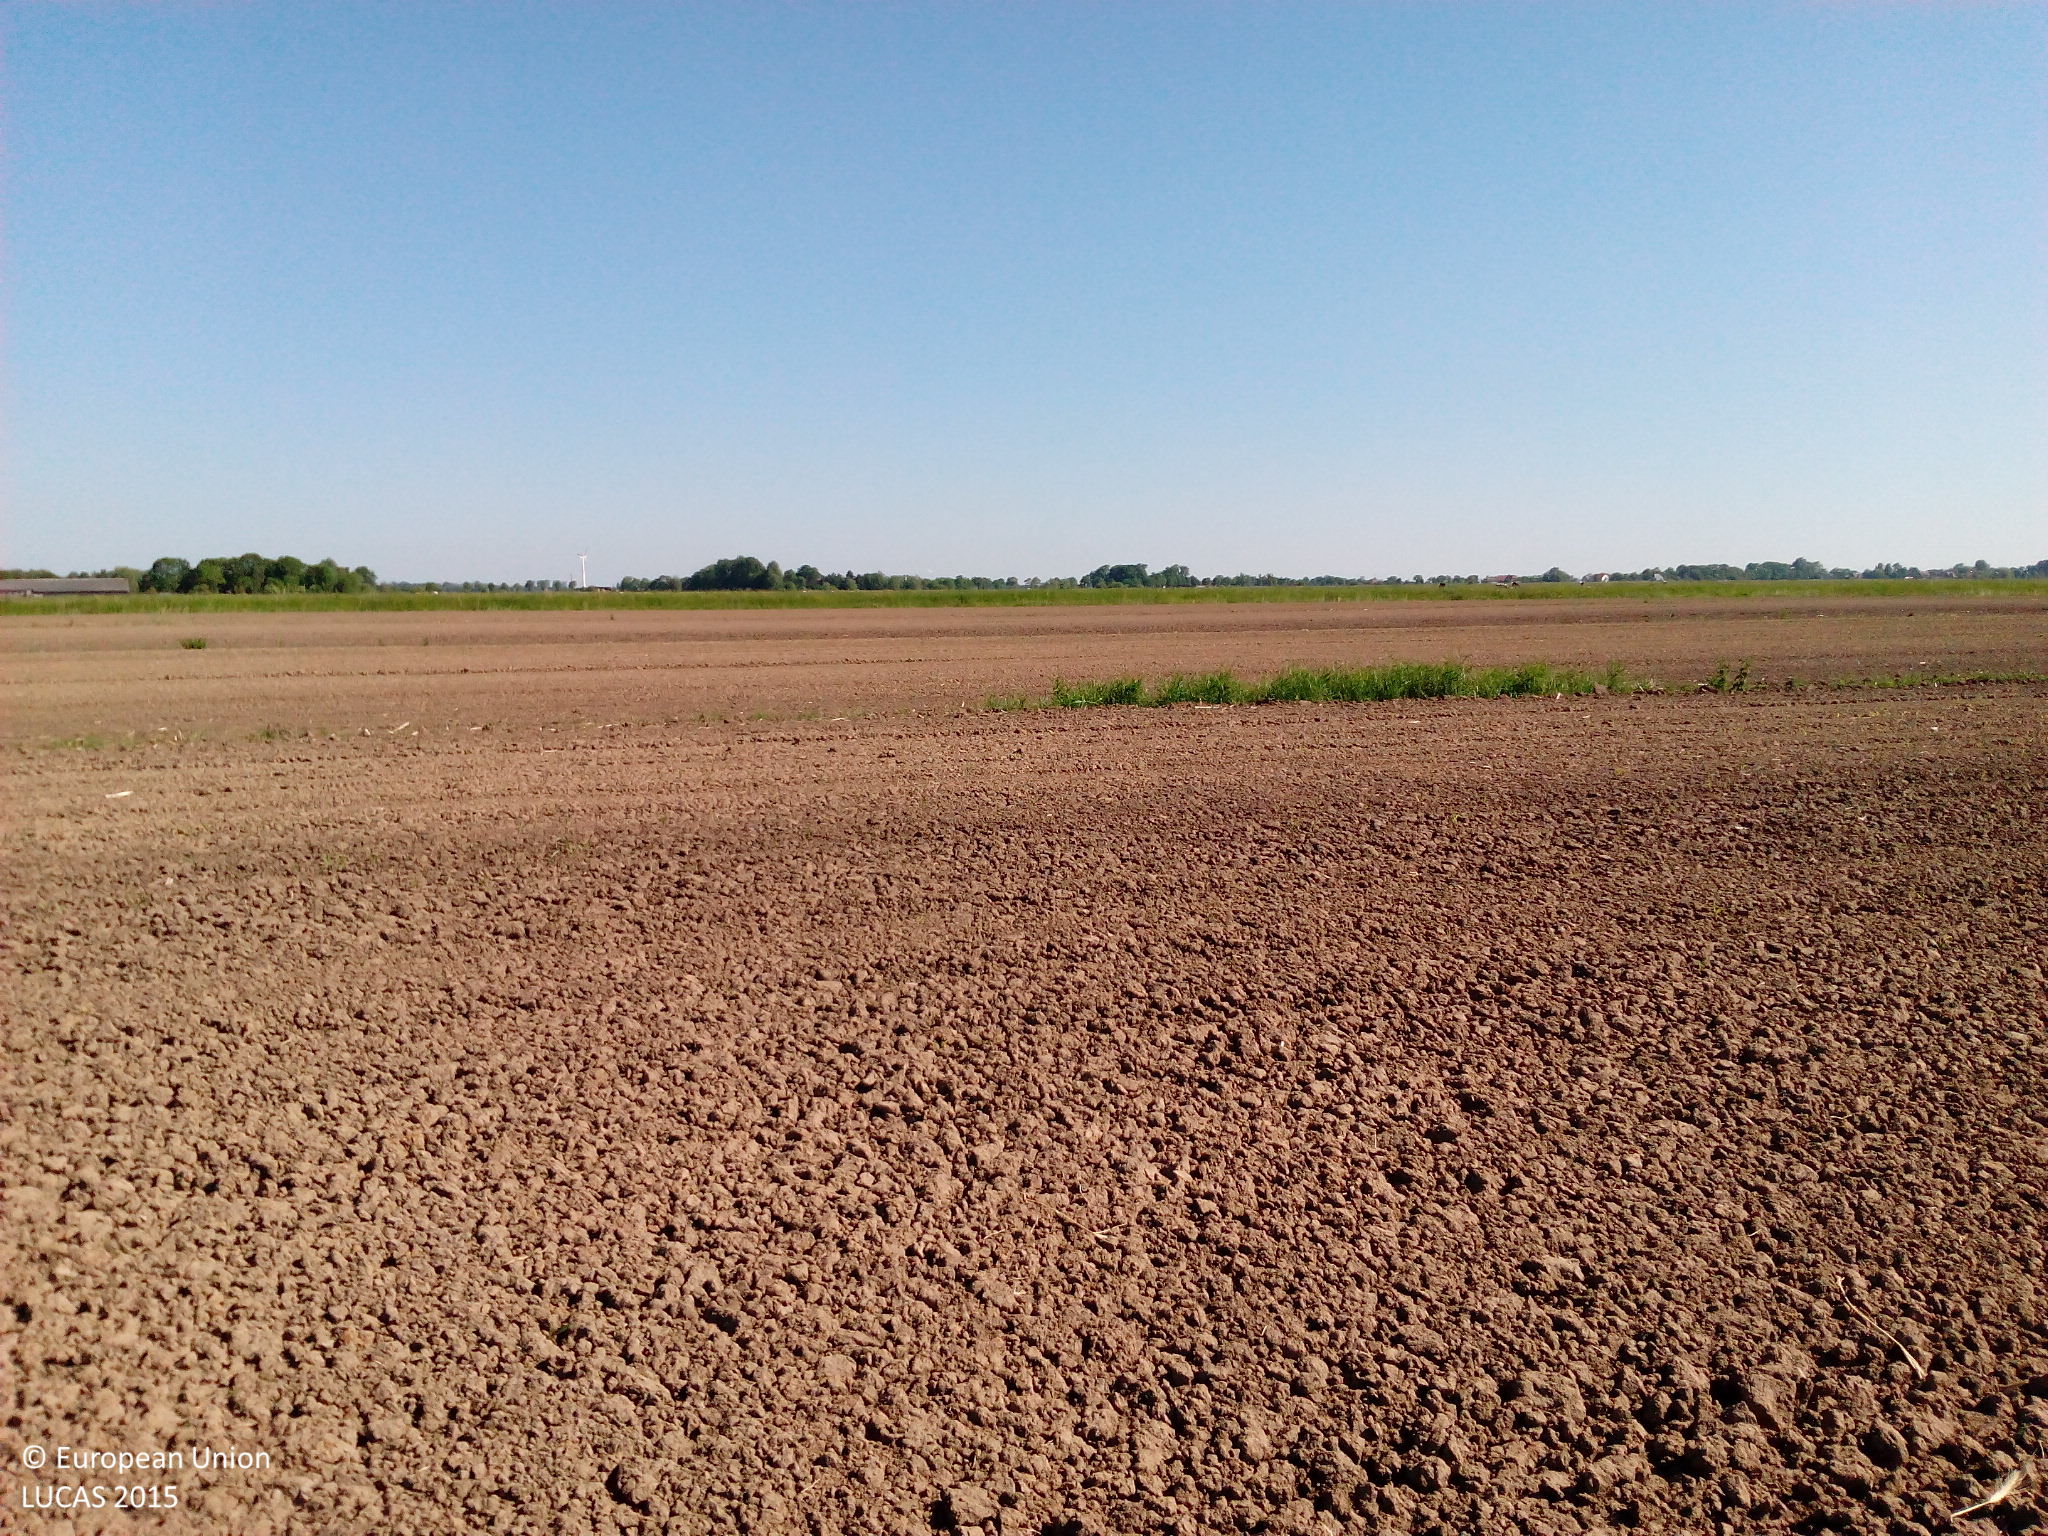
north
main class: Cropland
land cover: Maize
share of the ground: < 10 %
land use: Agriculture (excluding fallow land and kitchen gardens)
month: June
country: DE
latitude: 53.4108
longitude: 8.5113
